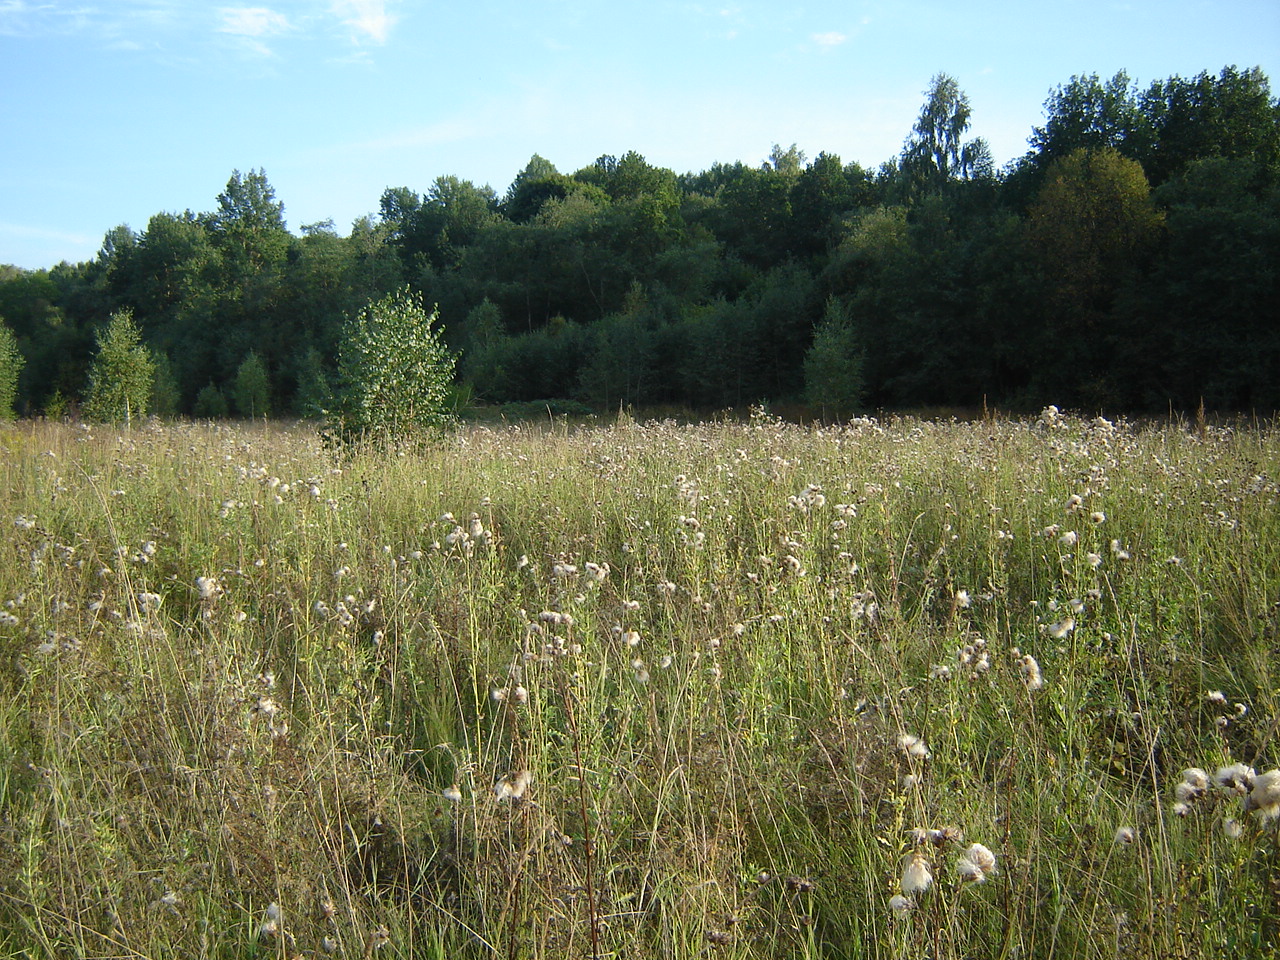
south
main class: Grassland
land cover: Spontaneously vegetated surfaces
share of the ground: > 75 %
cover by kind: herbaceous plants 100 %
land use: Fallow land
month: August
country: LT
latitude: 54.6025
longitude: 25.1495
